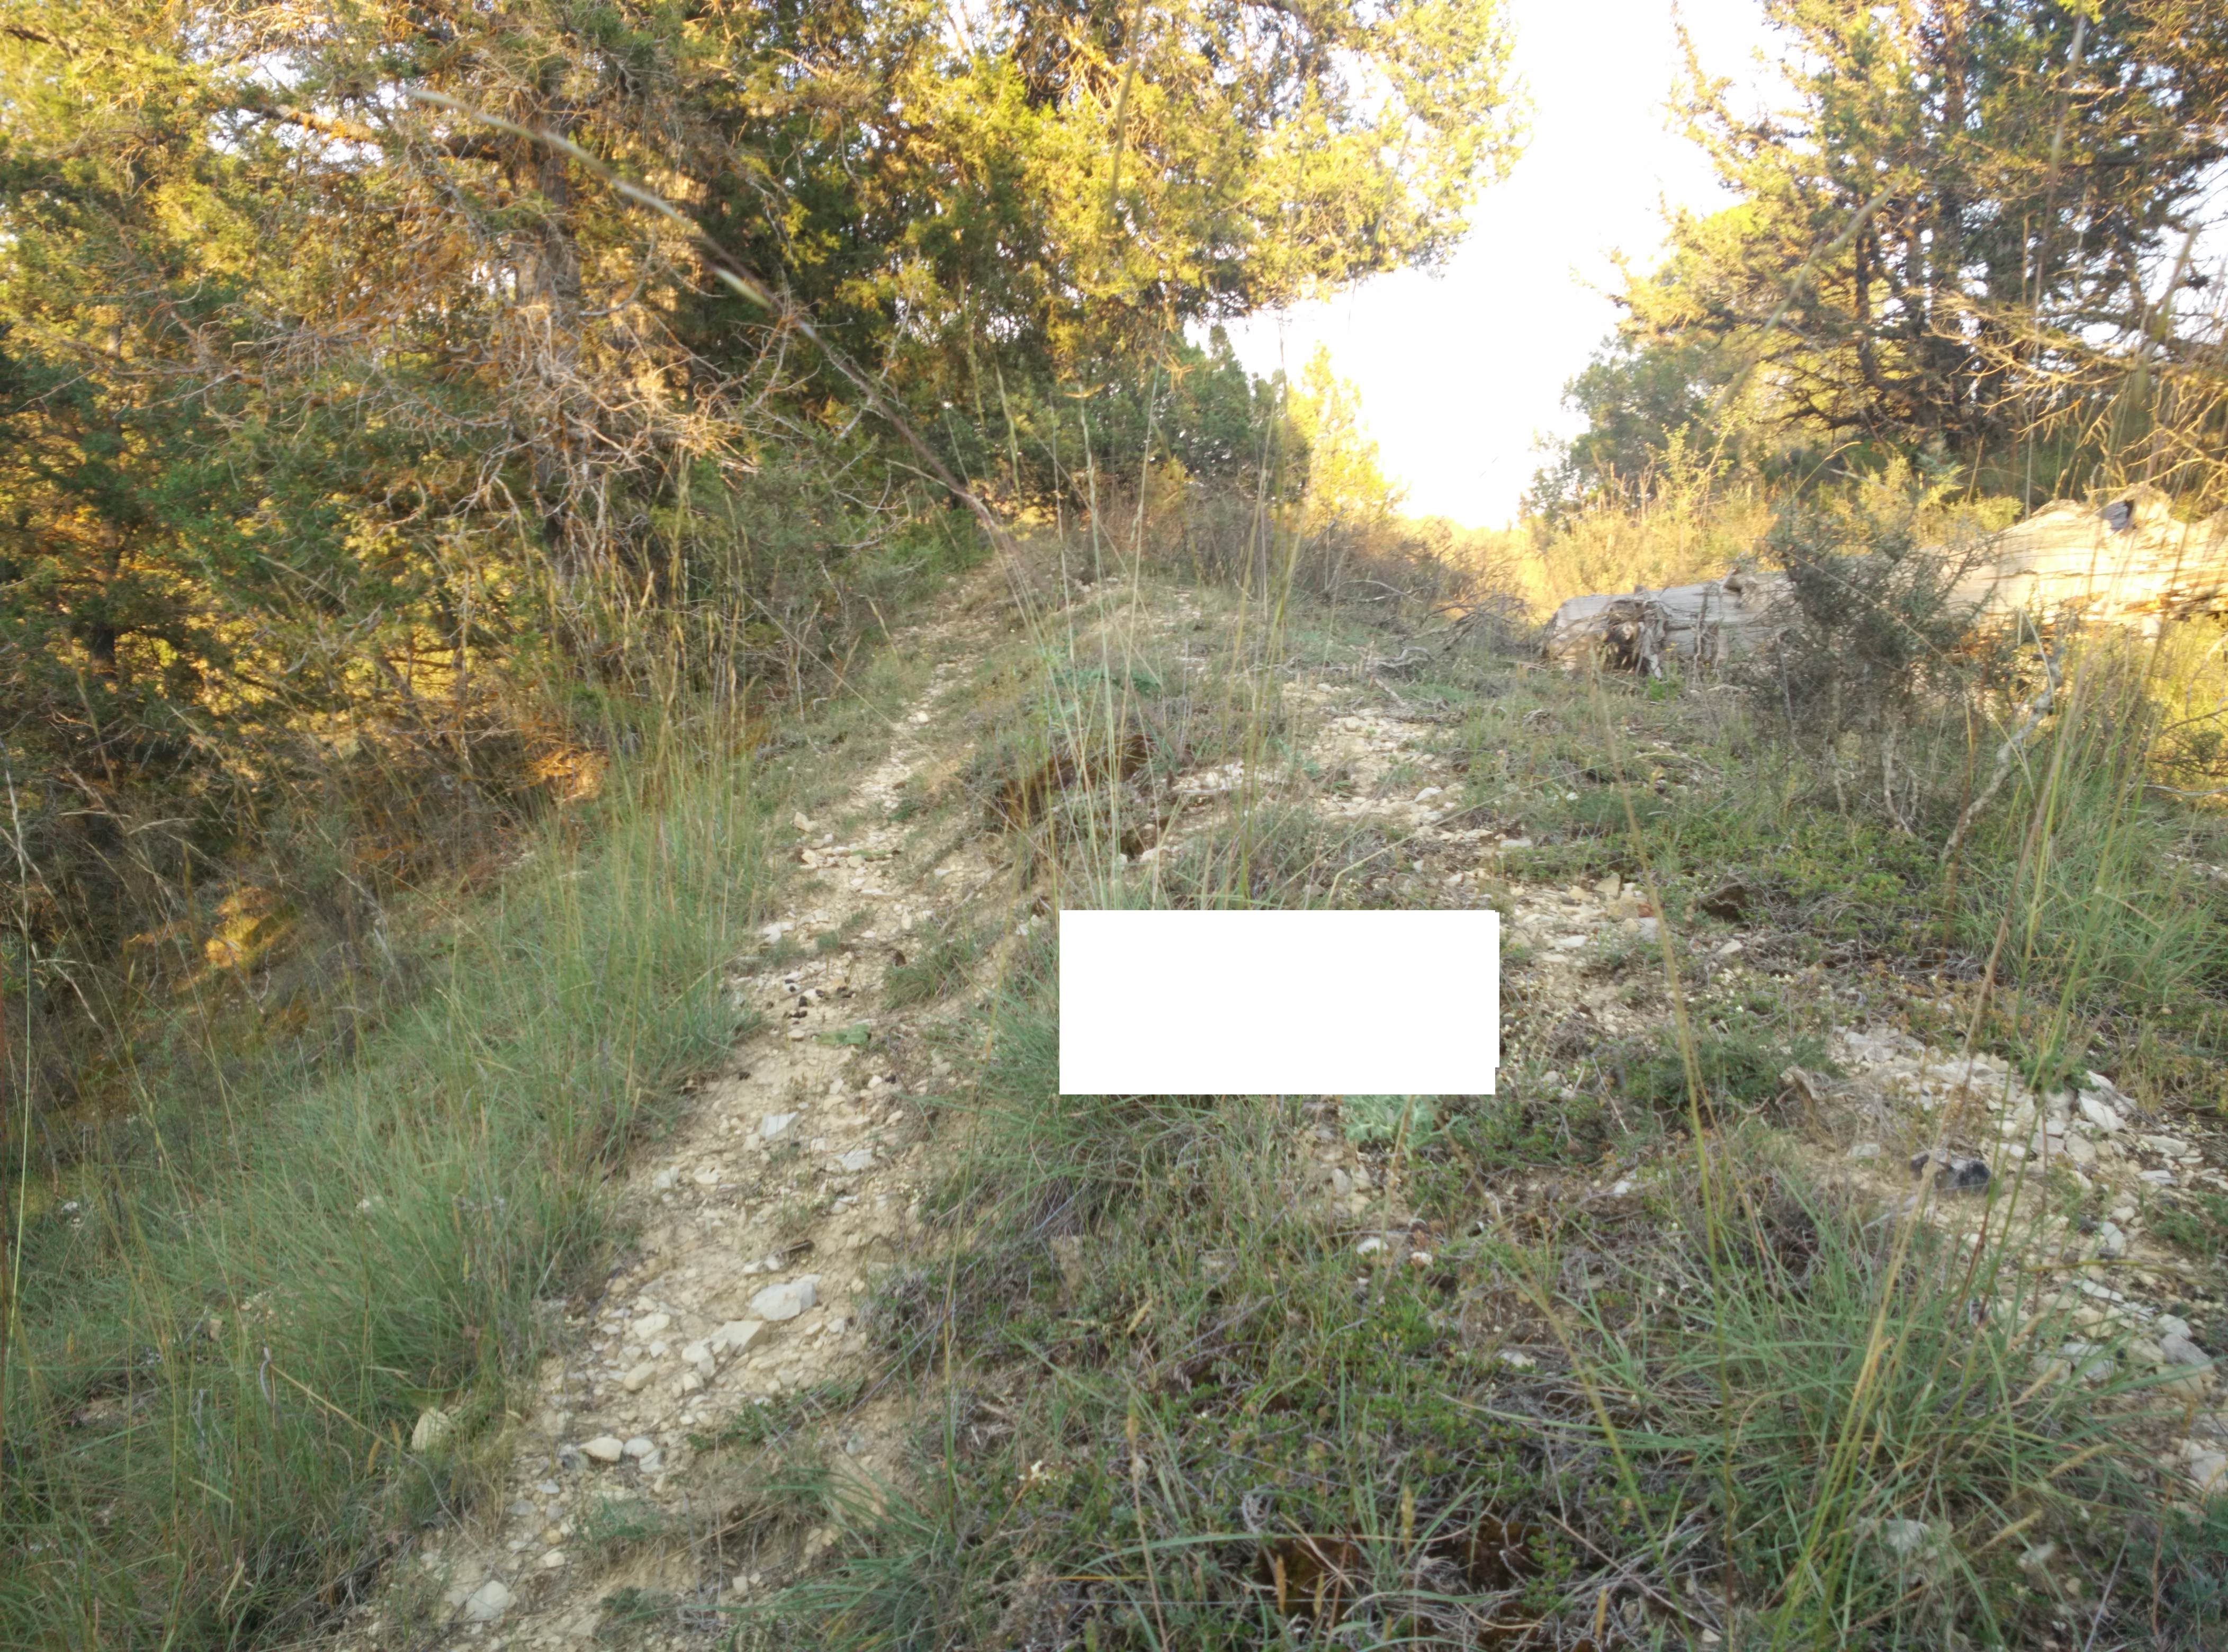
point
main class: Woodland
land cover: Other coniferous woodland
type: coniferous forest of the mediterranean region
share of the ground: 25 - 50 %
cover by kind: unconsolidated bare surface 50 %, coniferous forest trees 25 %, shrubs 15 %, herbaceous plants 10 %
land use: Semi-natural and natural areas not in use
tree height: > 5 m
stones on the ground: > 50 %
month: June
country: ES
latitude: 40.7671
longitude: -2.0235
